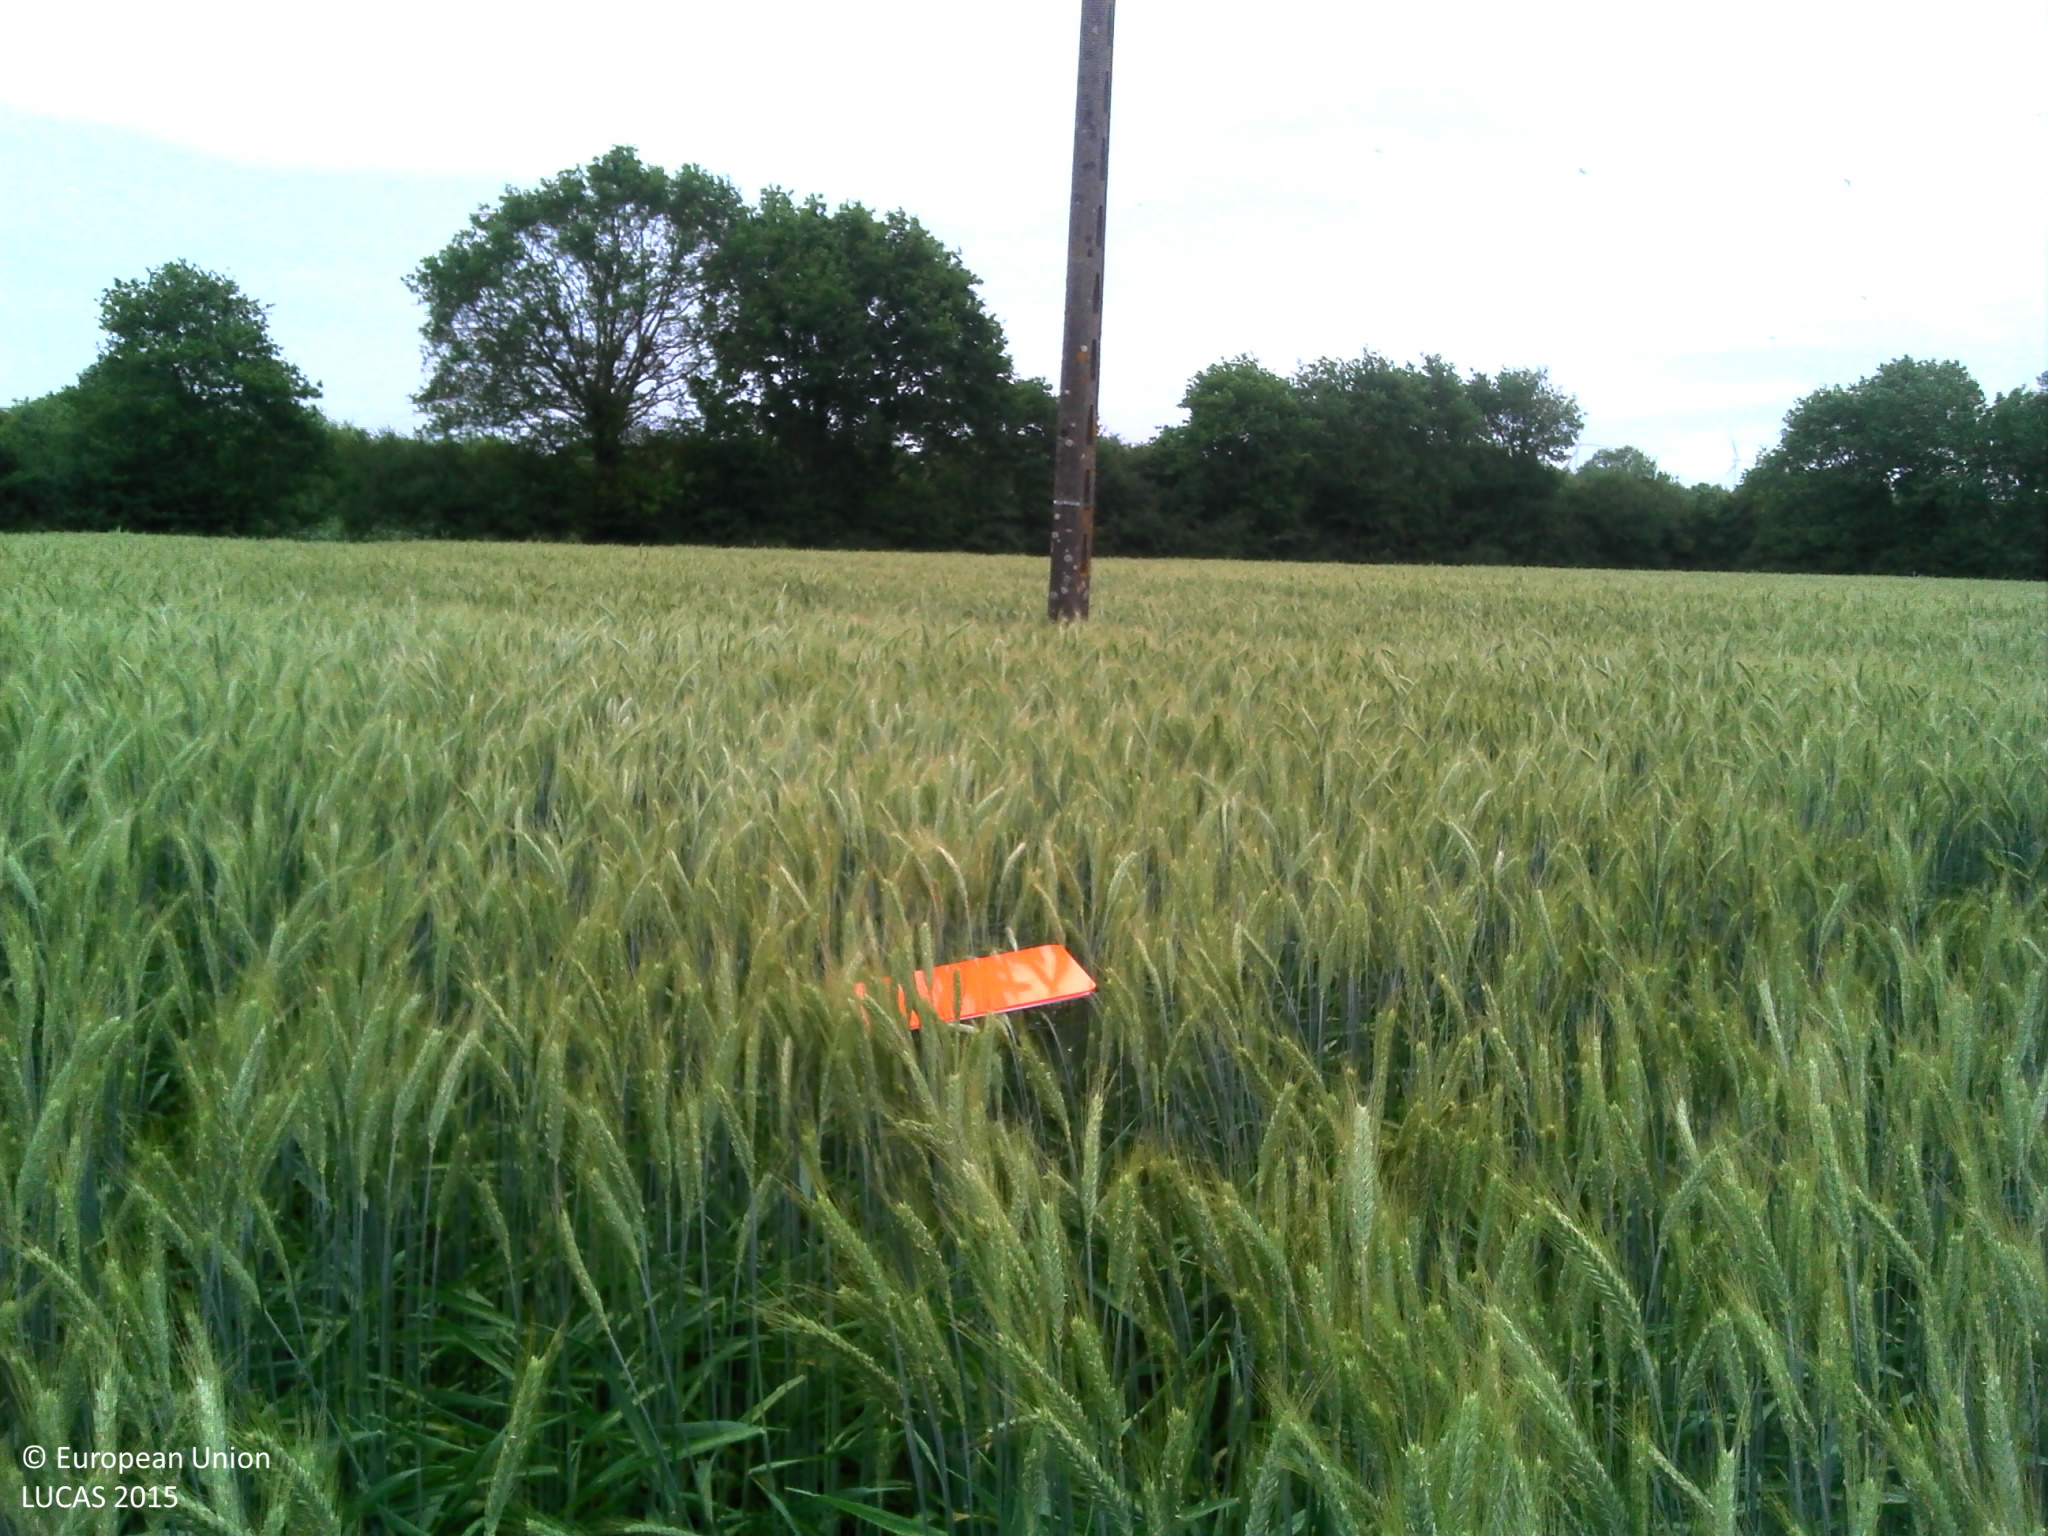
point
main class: Cropland
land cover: Triticale
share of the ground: > 75 %
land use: Agriculture (excluding fallow land and kitchen gardens)
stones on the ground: < 10 %
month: June
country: FR
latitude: 46.8794
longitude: -1.7874
